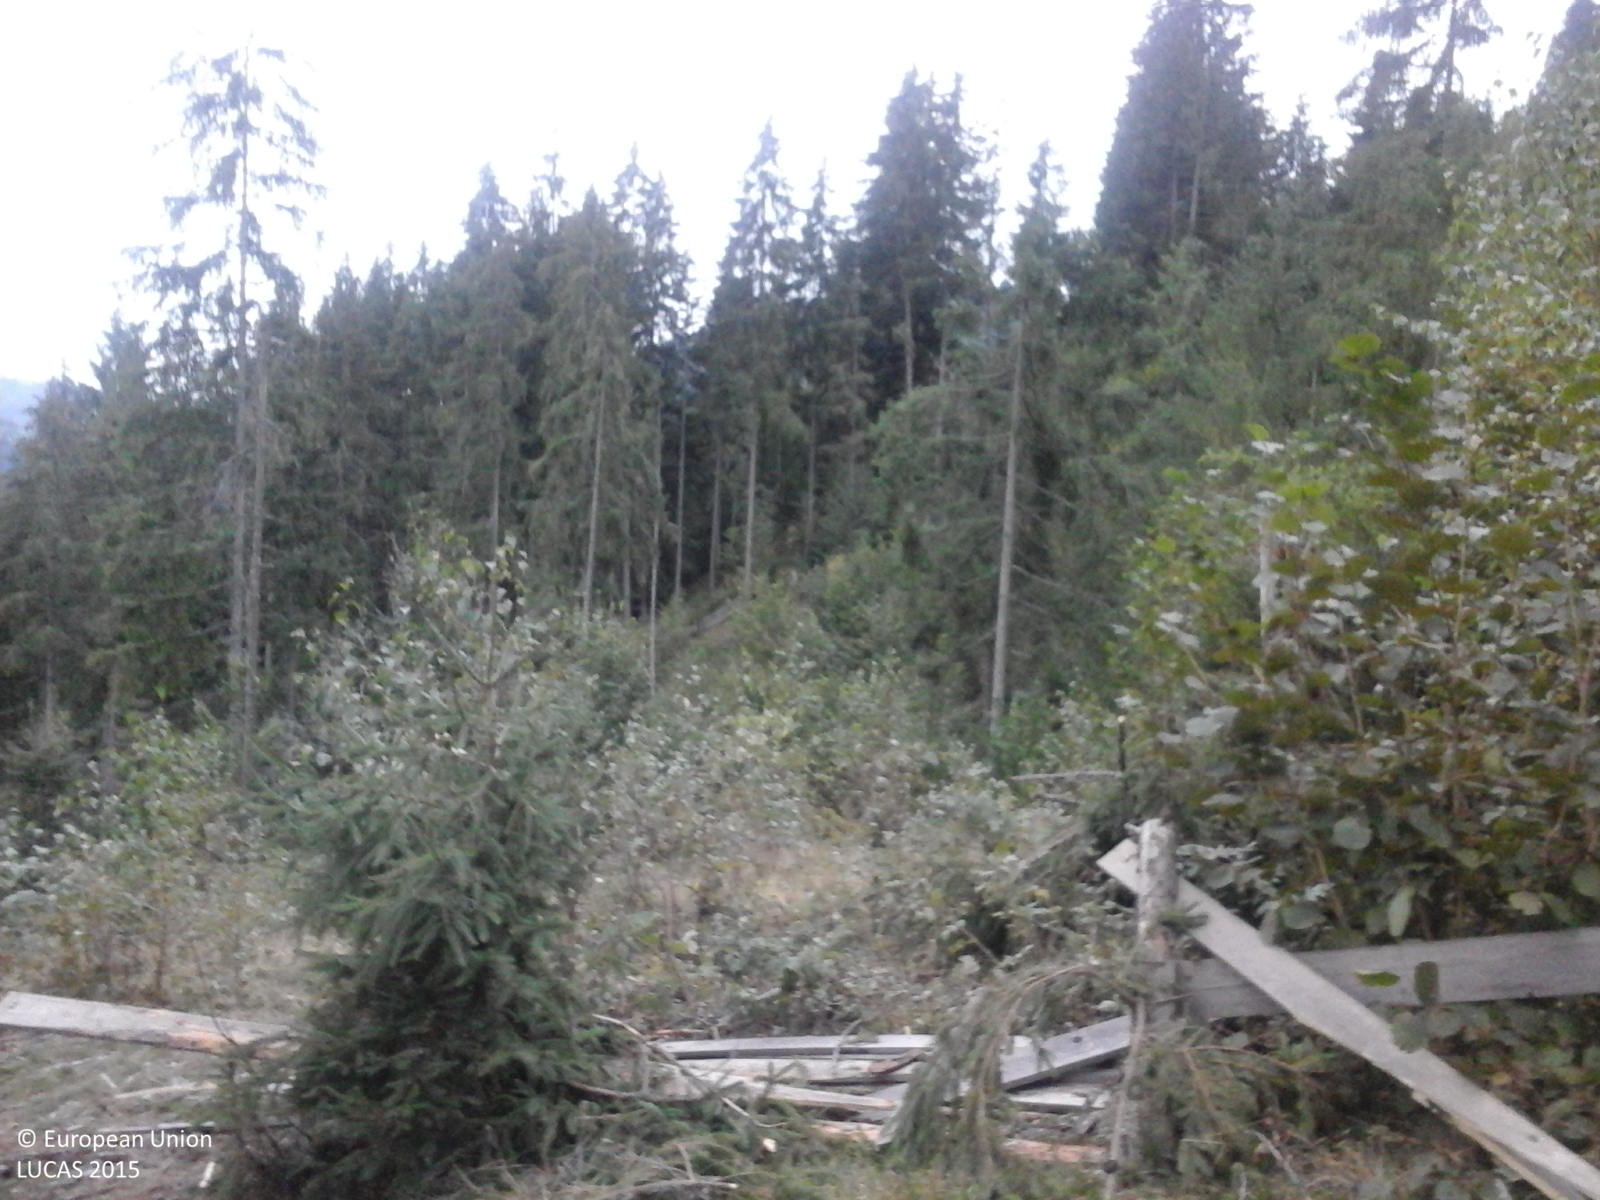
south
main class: Woodland
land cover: Spruce dominated mixed woodland
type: alpine coniferous forest
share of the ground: 50 - 75 %
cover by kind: coniferous forest trees 40 %, broadleaved forest trees 30 %, unconsolidated bare surface 10 %, shrubs 5 %, herbaceous plants 5 %
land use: Forestry
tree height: > 5 m
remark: Clear cut
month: September
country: RO
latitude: 46.5084
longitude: 22.9474
